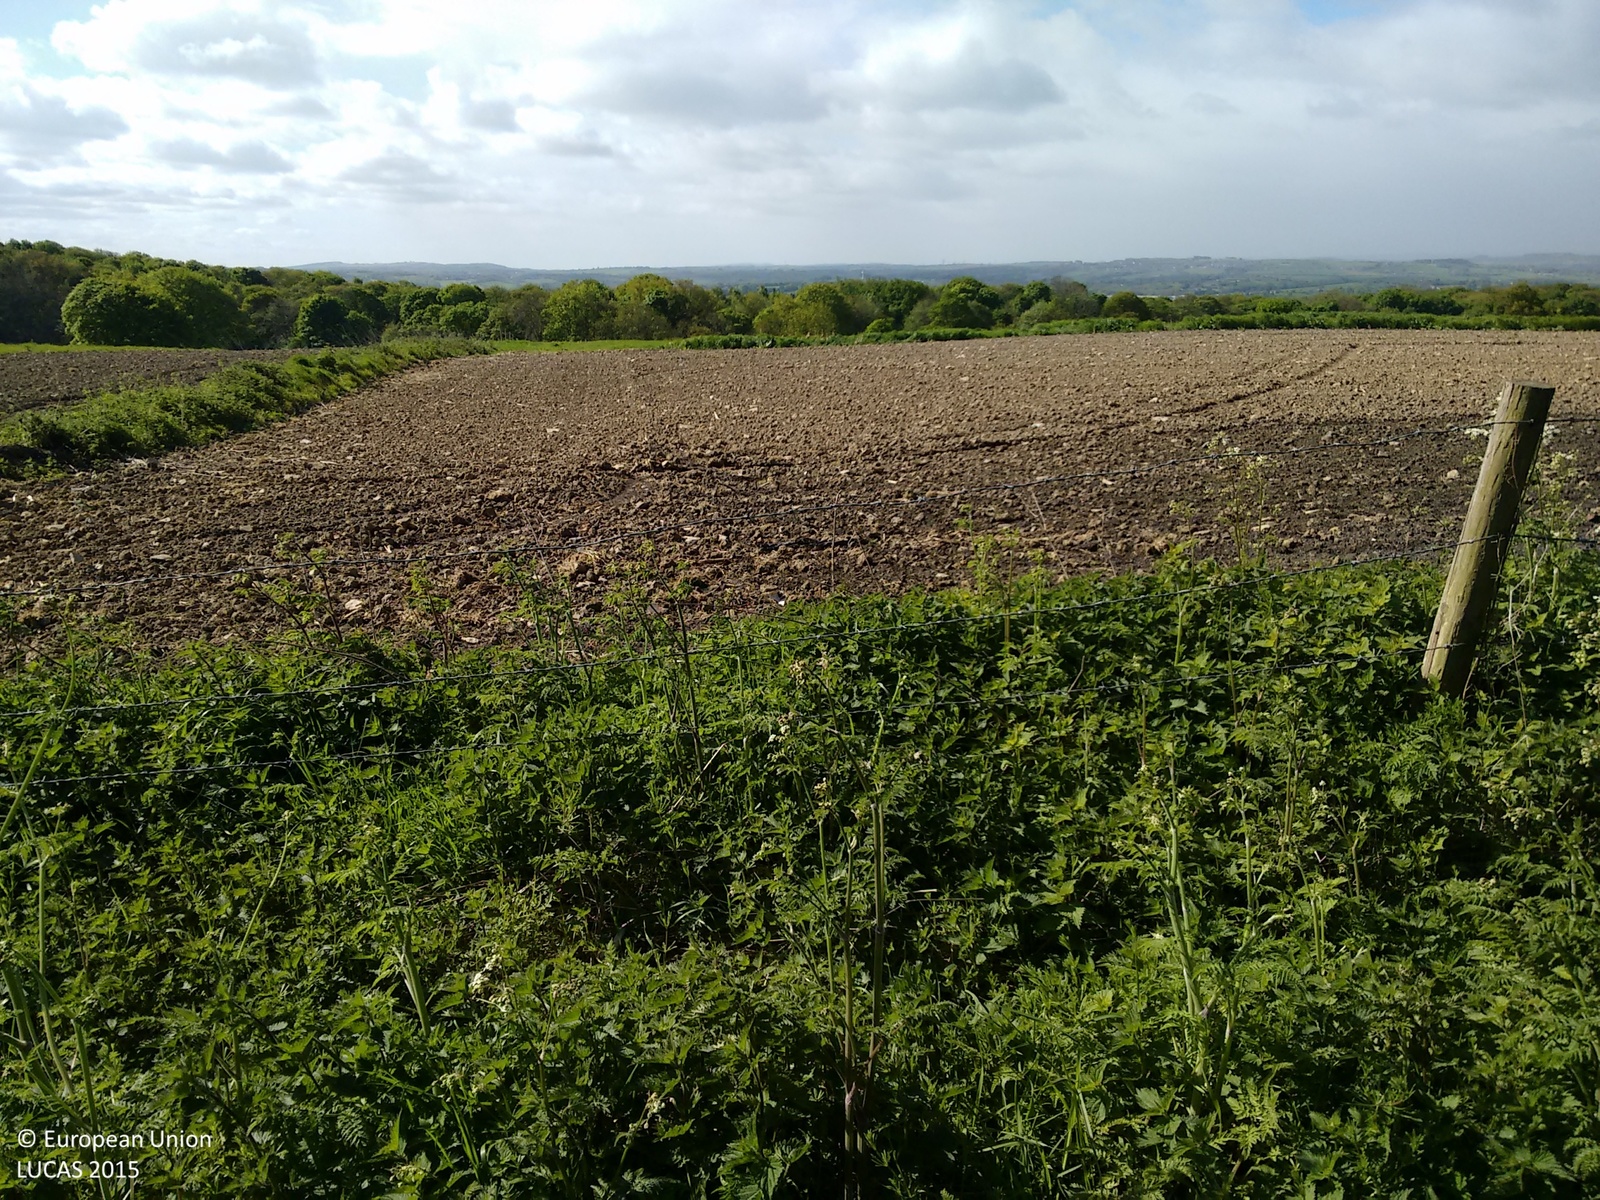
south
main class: Grassland
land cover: Grassland without tree/shrub cover
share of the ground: > 75 %
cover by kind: herbaceous plants 100 %
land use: Agriculture (excluding fallow land and kitchen gardens)
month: May
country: GB
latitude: 53.5894
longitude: -1.5779
